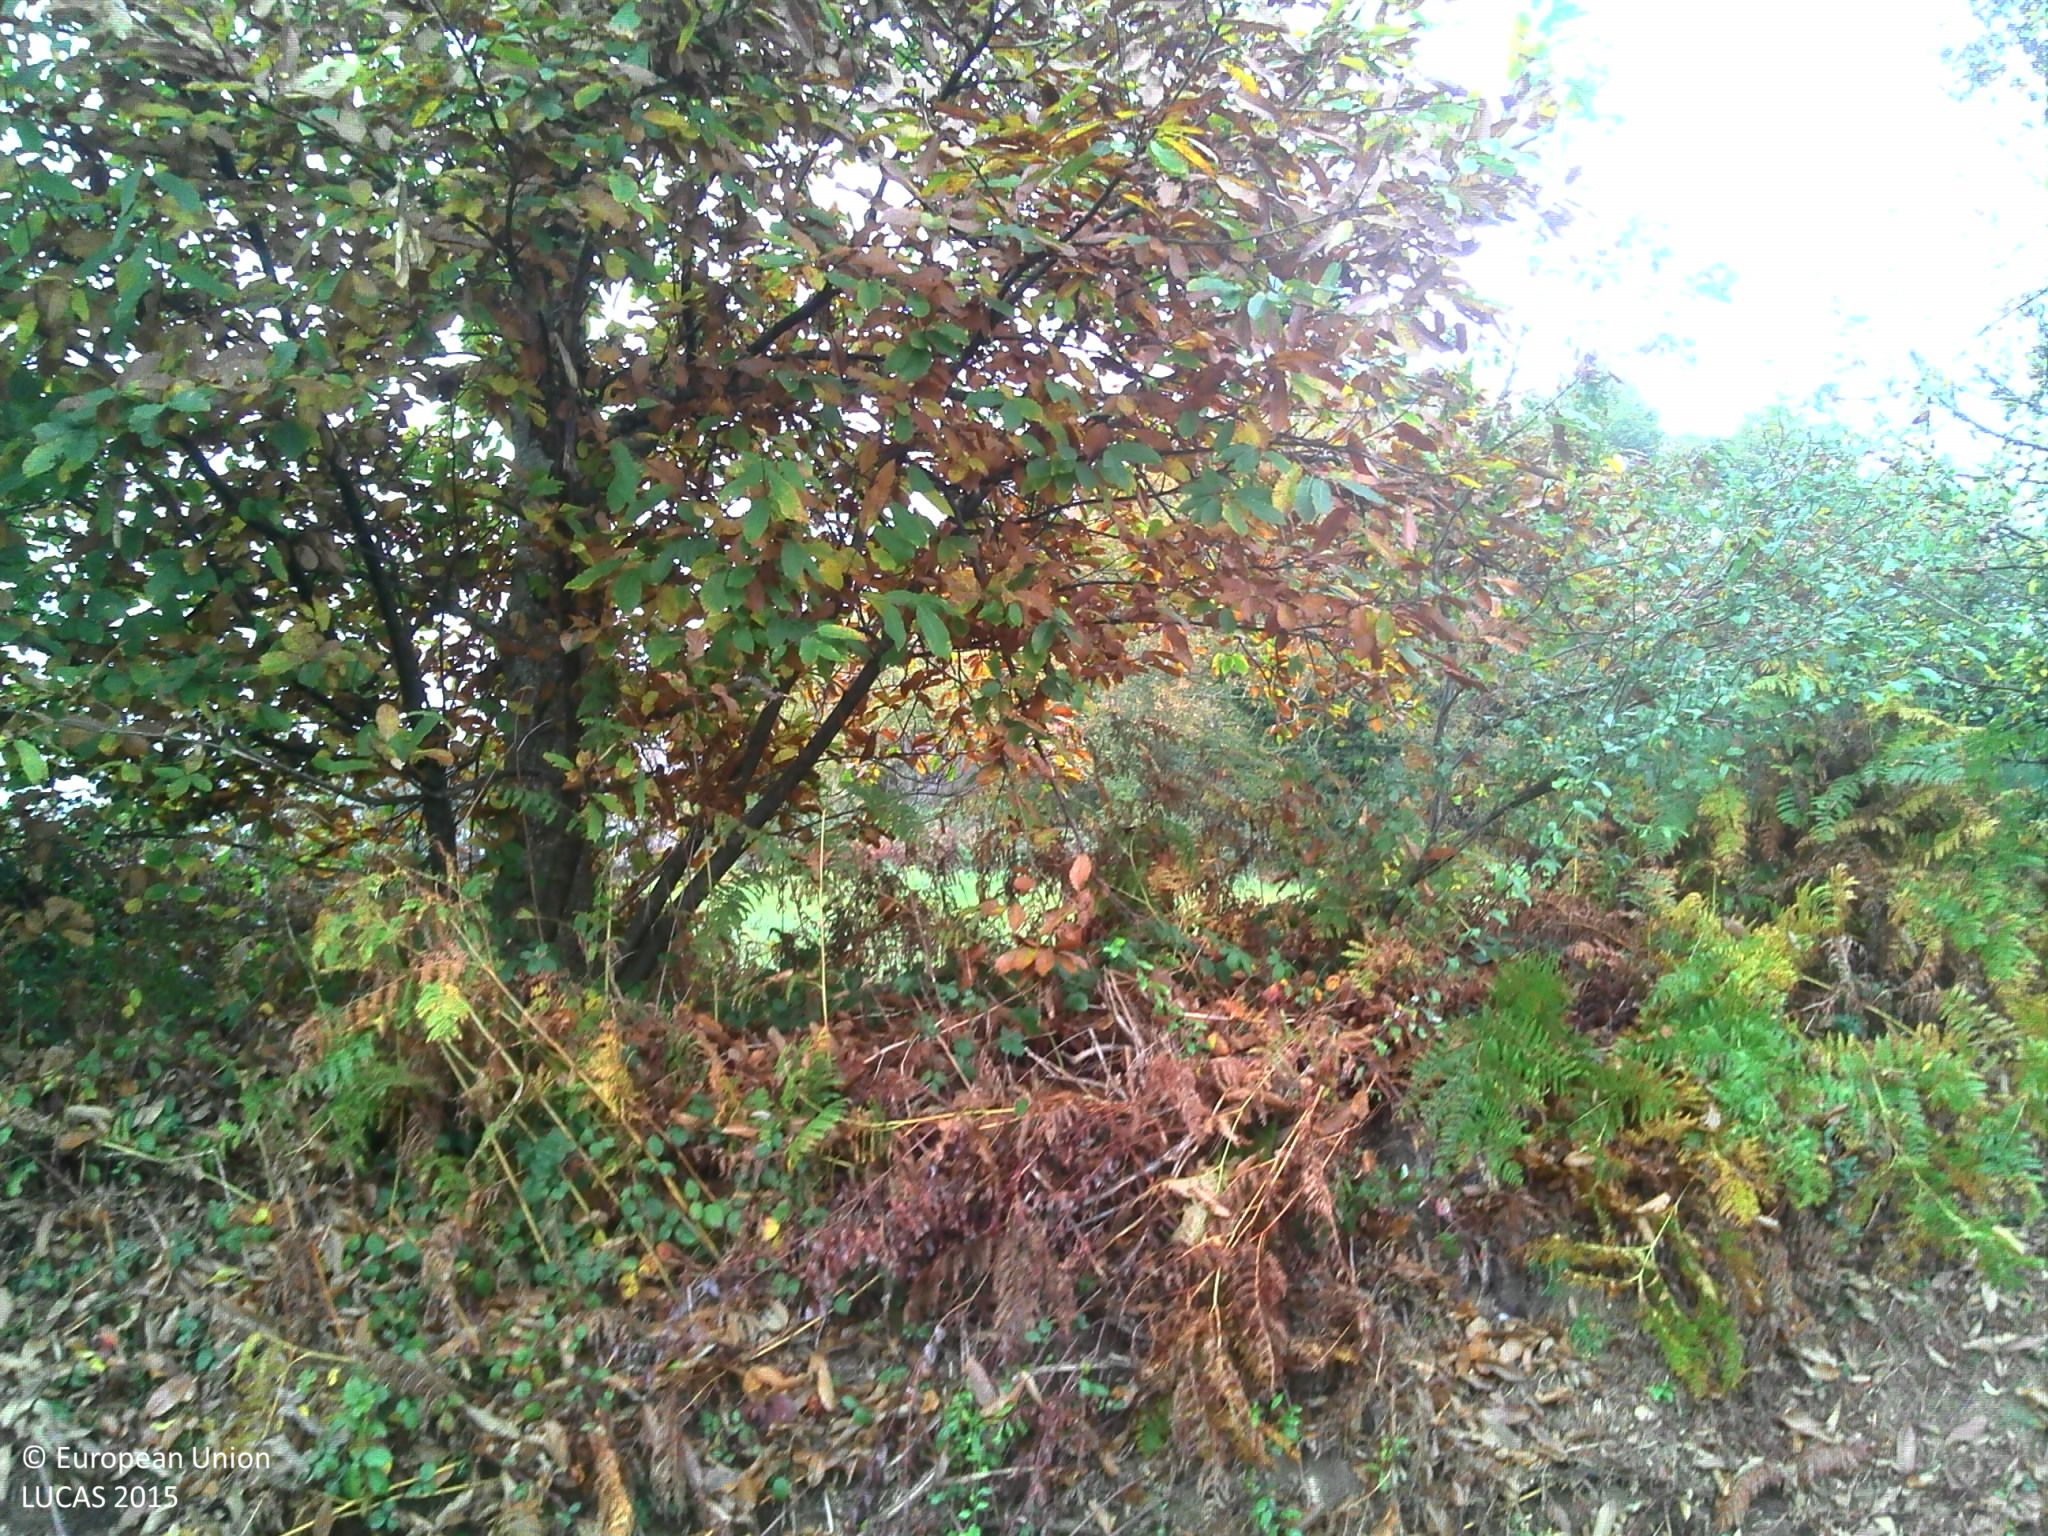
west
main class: Cropland
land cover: Maize
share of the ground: > 75 %
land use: Agriculture (excluding fallow land and kitchen gardens)
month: November
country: FR
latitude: 47.9725
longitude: -3.0487
